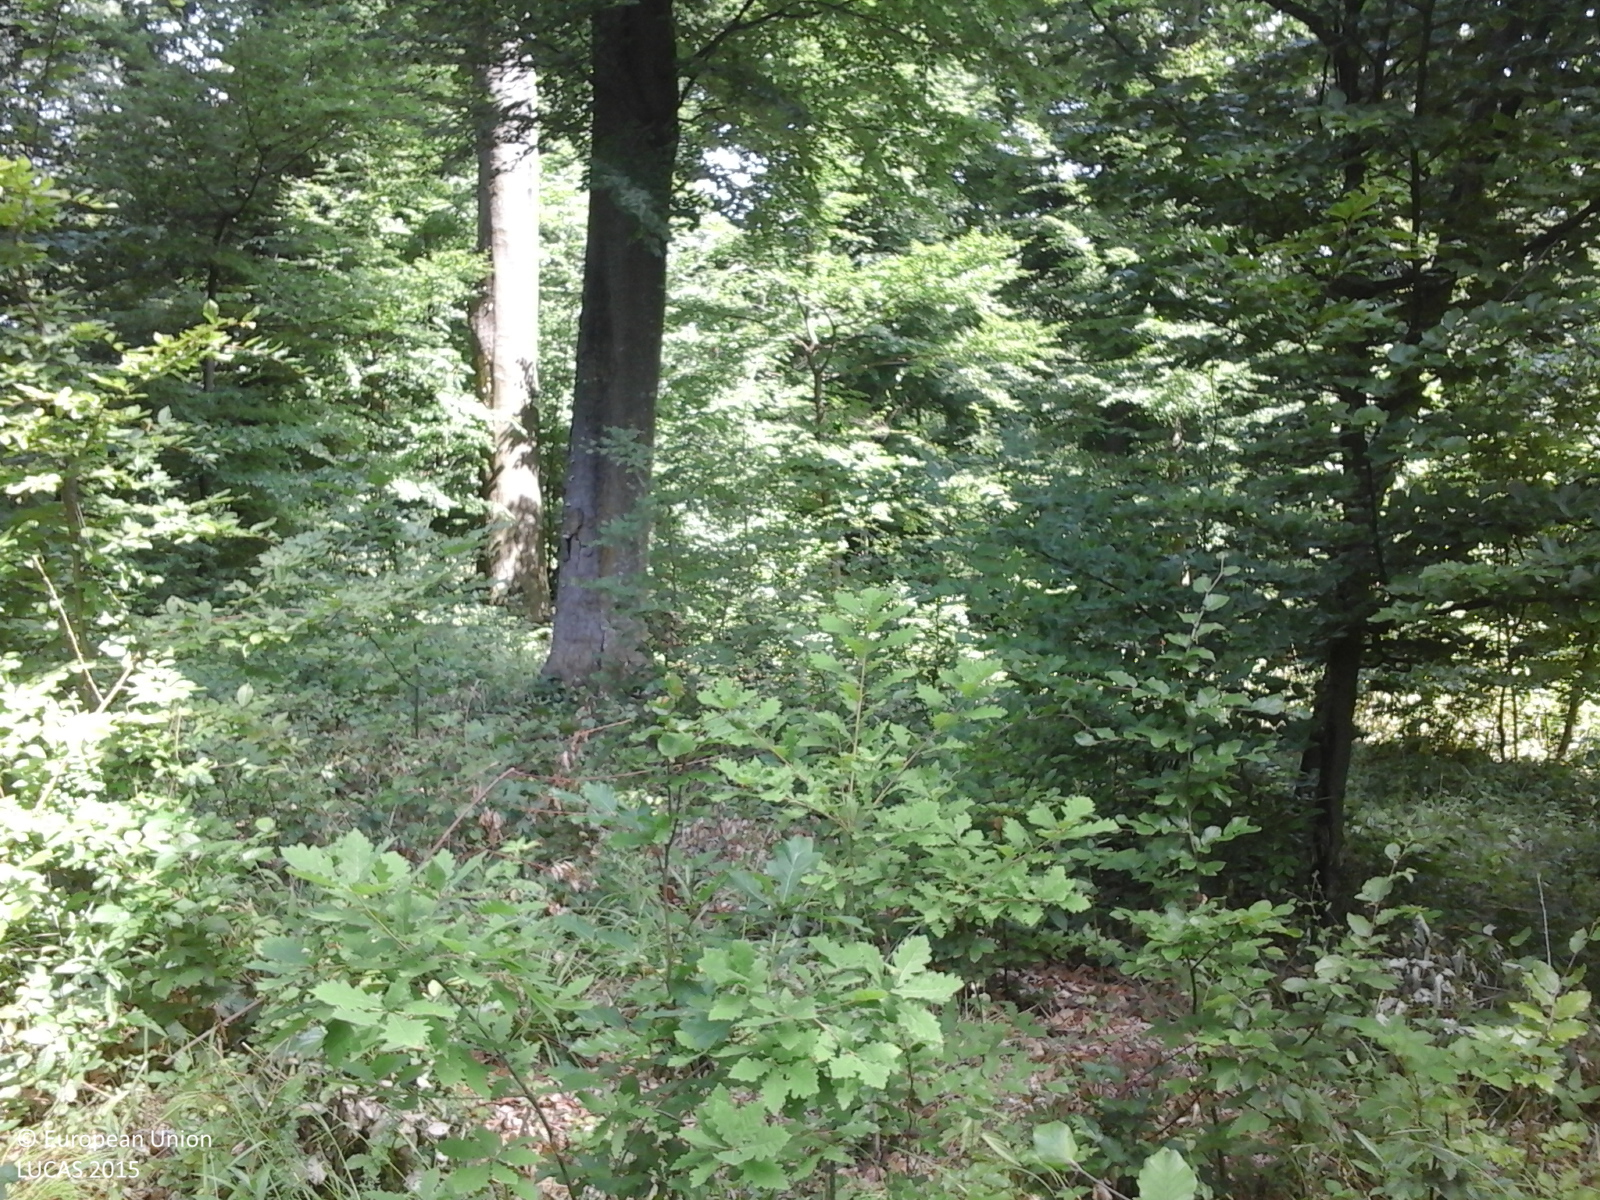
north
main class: Woodland
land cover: Broadleaved woodland
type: beech forest
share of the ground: > 75 %
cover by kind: broadleaved forest trees 90 %, herbaceous plants 10 %
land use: Forestry
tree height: > 5 m
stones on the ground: < 10 %
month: June
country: RO
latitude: 47.1328
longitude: 26.7443
